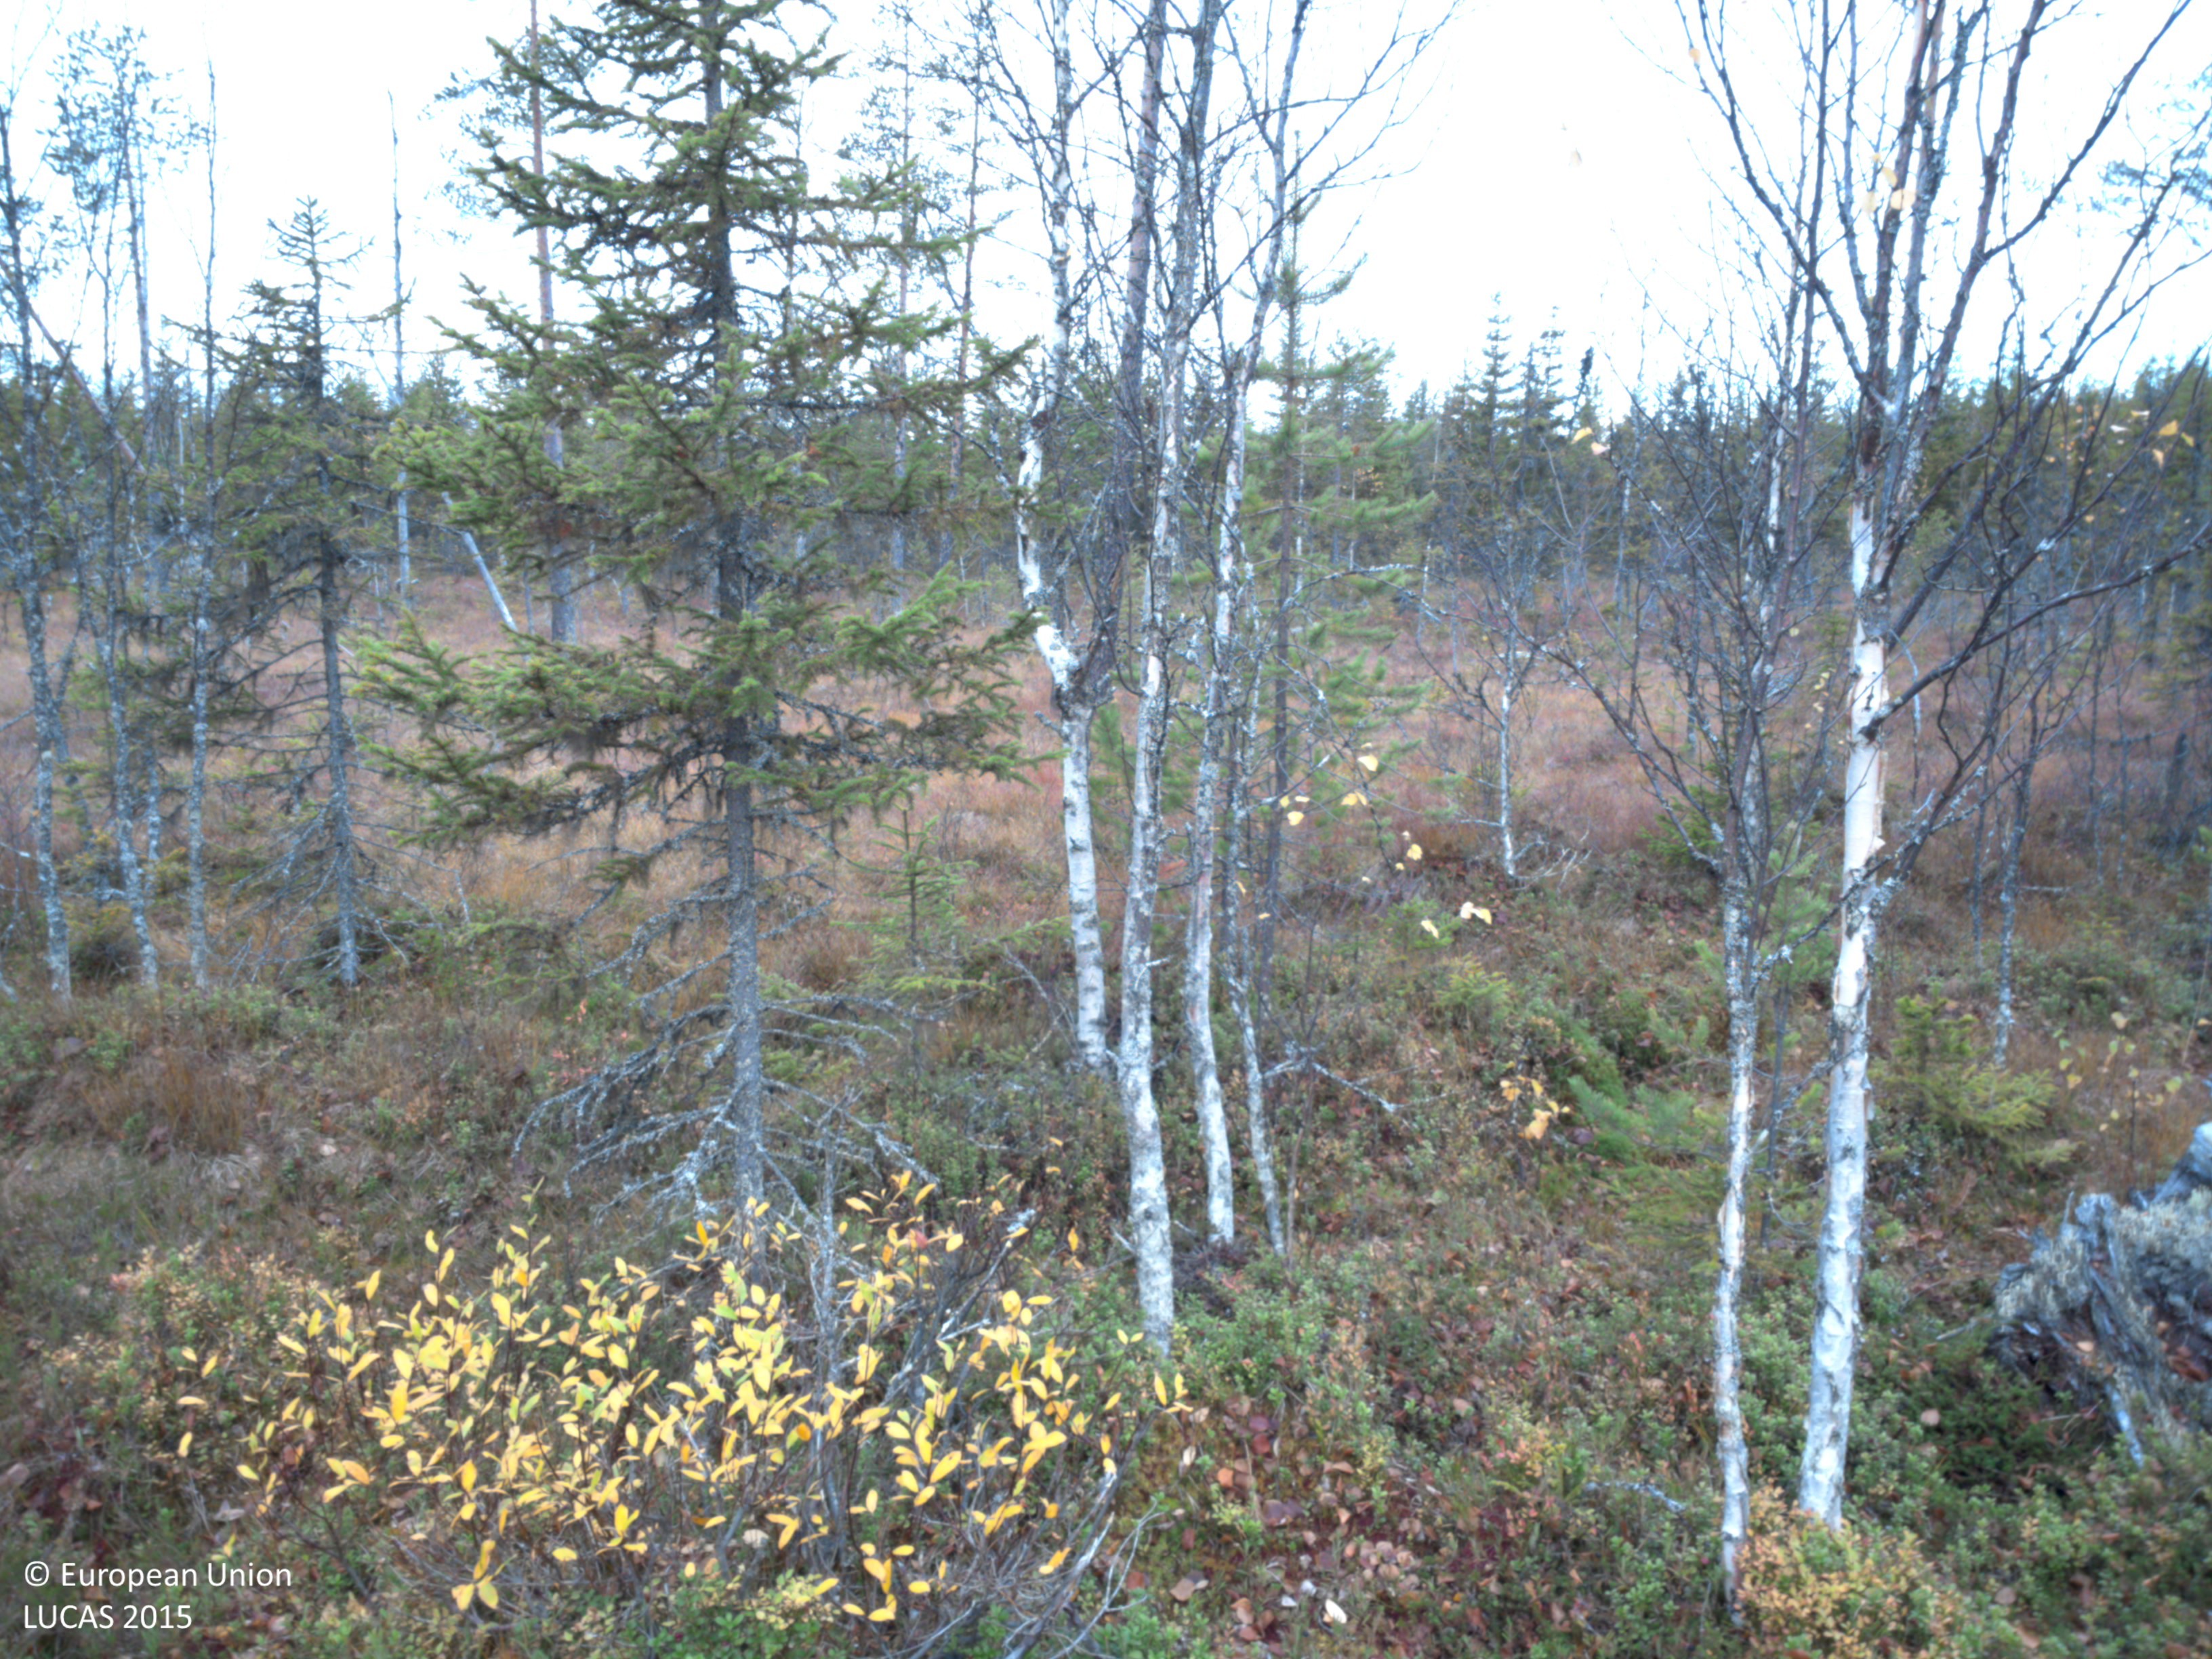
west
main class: Woodland
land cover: Spruce dominated mixed woodland
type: boreal forest
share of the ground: 25 - 50 %
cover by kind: shrubs 50 %, coniferous forest trees 30 %, broadleaved forest trees 10 %, herbaceous plants 5 %, lichens and mosses 5 %
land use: Forestry
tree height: < 5 m
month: October
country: SE
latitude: 64.6945
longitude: 18.2066
